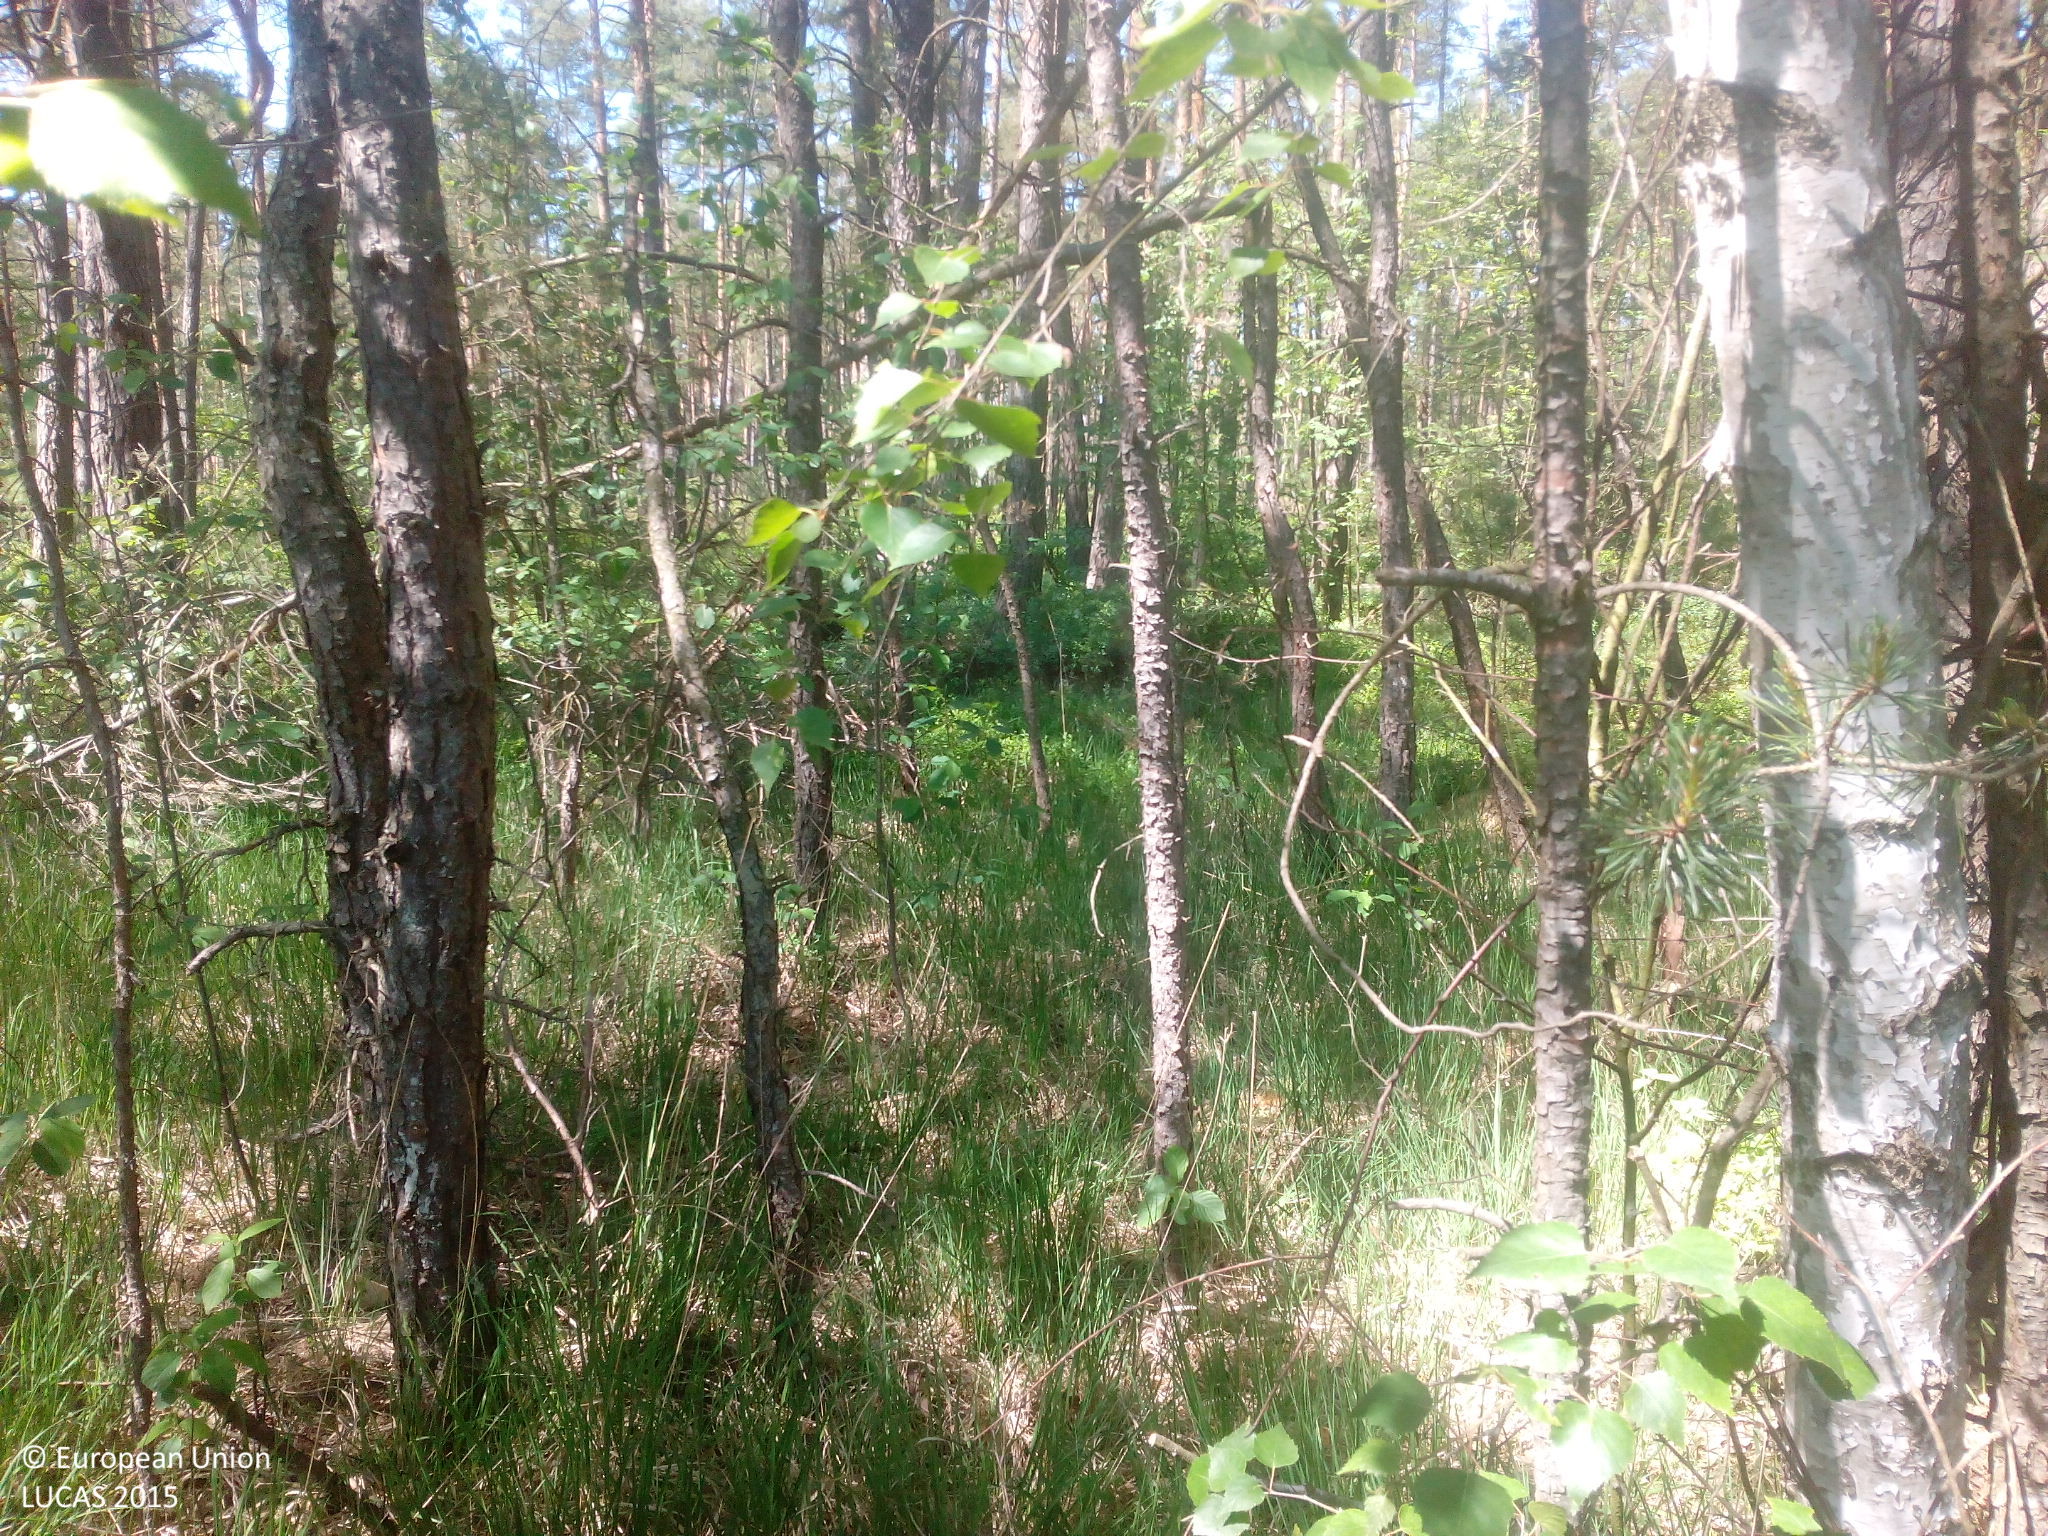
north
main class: Woodland
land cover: Pine dominated mixed woodland
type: hemiboreal forest and nemoral coniferous forest and mixed broadleaved-coniferous forest
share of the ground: 50 - 75 %
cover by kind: coniferous forest trees 50 %, broadleaved forest trees 20 %, herbaceous plants 20 %
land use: Amenities, museums, leisure
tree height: > 5 m
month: June
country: DE
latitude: 49.2407
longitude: 12.4306
